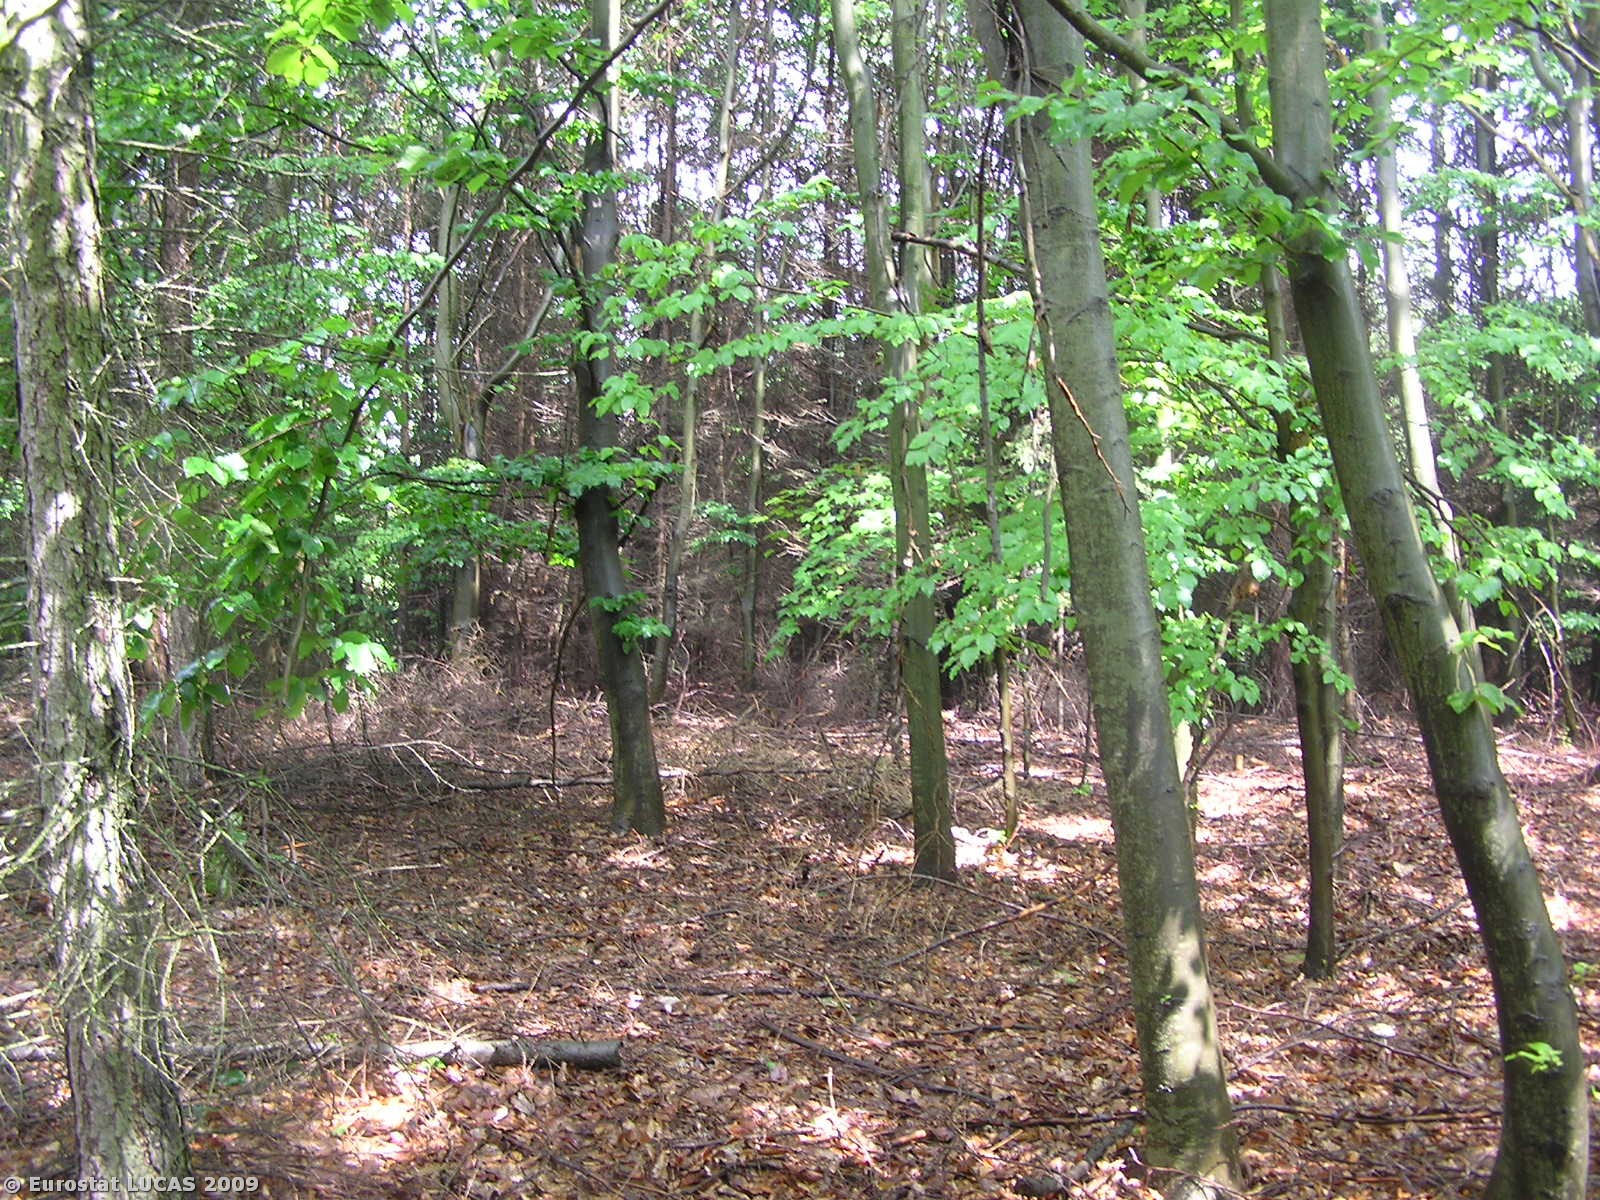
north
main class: Woodland
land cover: Broadleaved woodland
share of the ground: > 75 %
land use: Forestry
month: June
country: CZ
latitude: 49.6780
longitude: 15.0055
